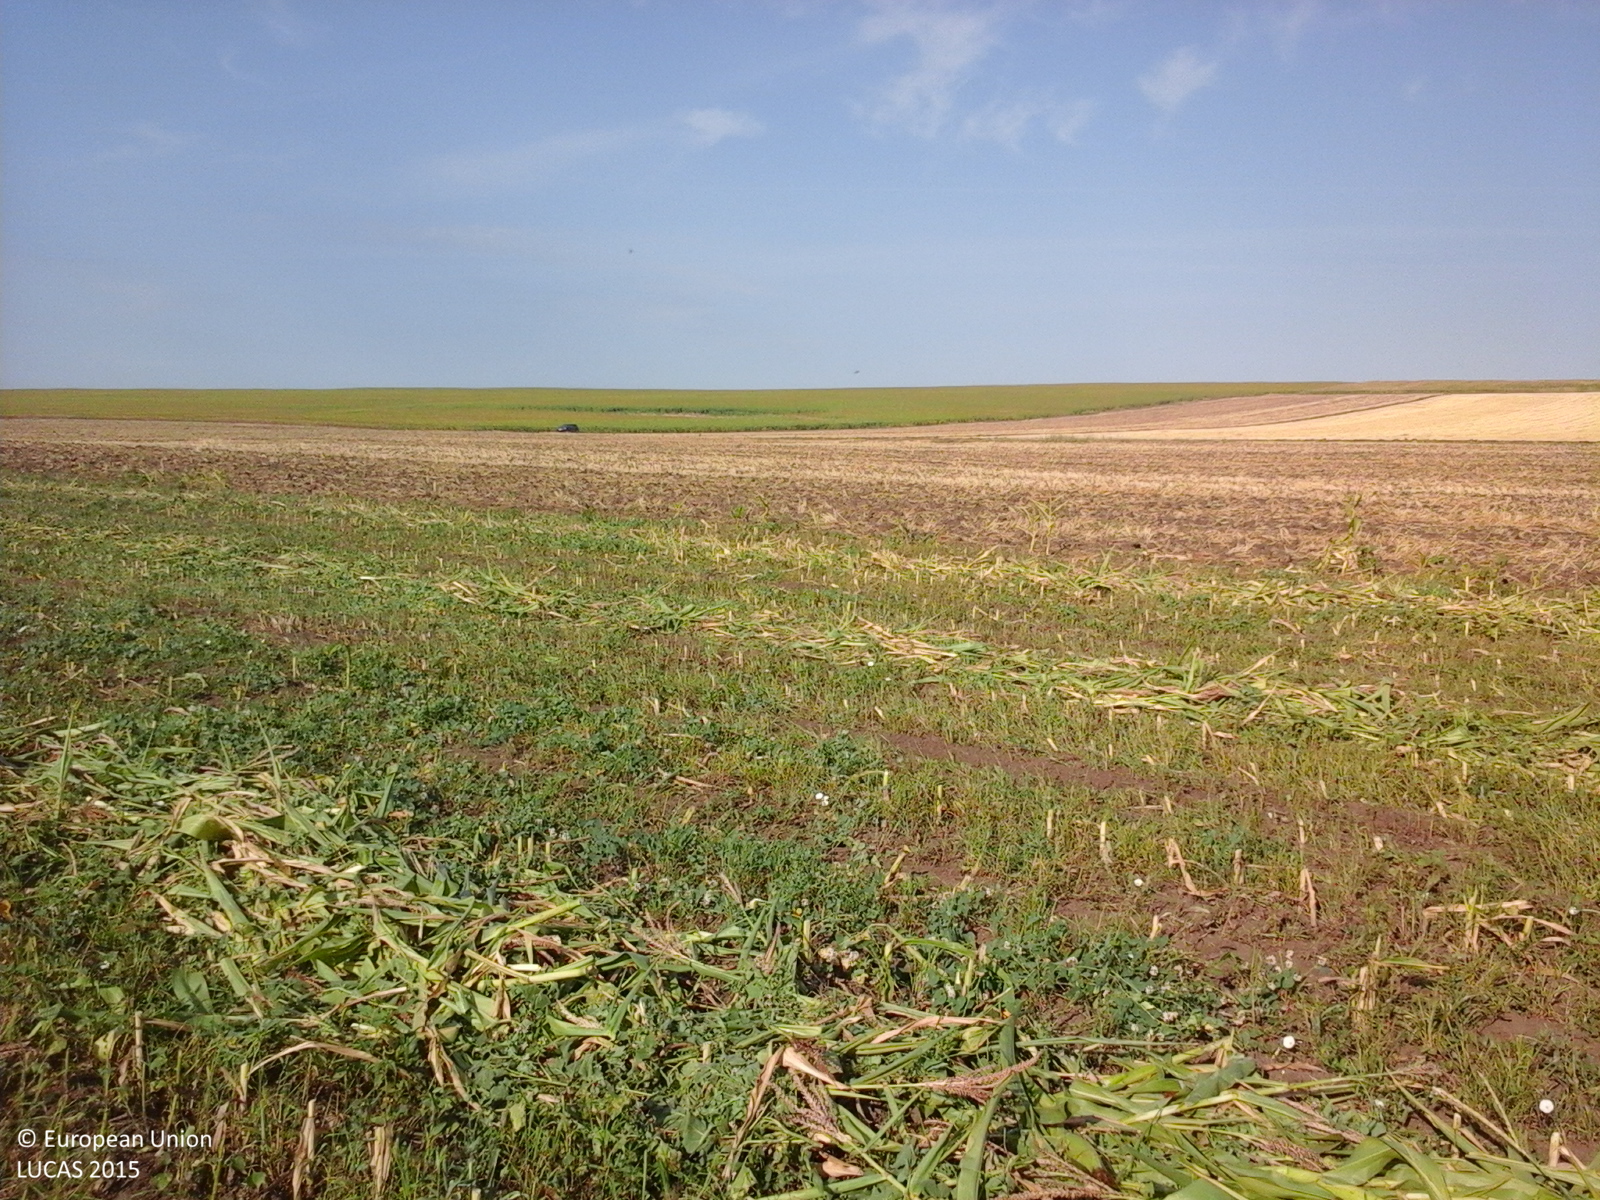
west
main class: Cropland
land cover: Maize
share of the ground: 25 - 50 %
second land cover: Spontaneously vegetated surfaces
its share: 50 - 75 %
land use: Agriculture (excluding fallow land and kitchen gardens)
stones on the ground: < 10 %
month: July
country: RO
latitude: 46.2660
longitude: 28.0976
